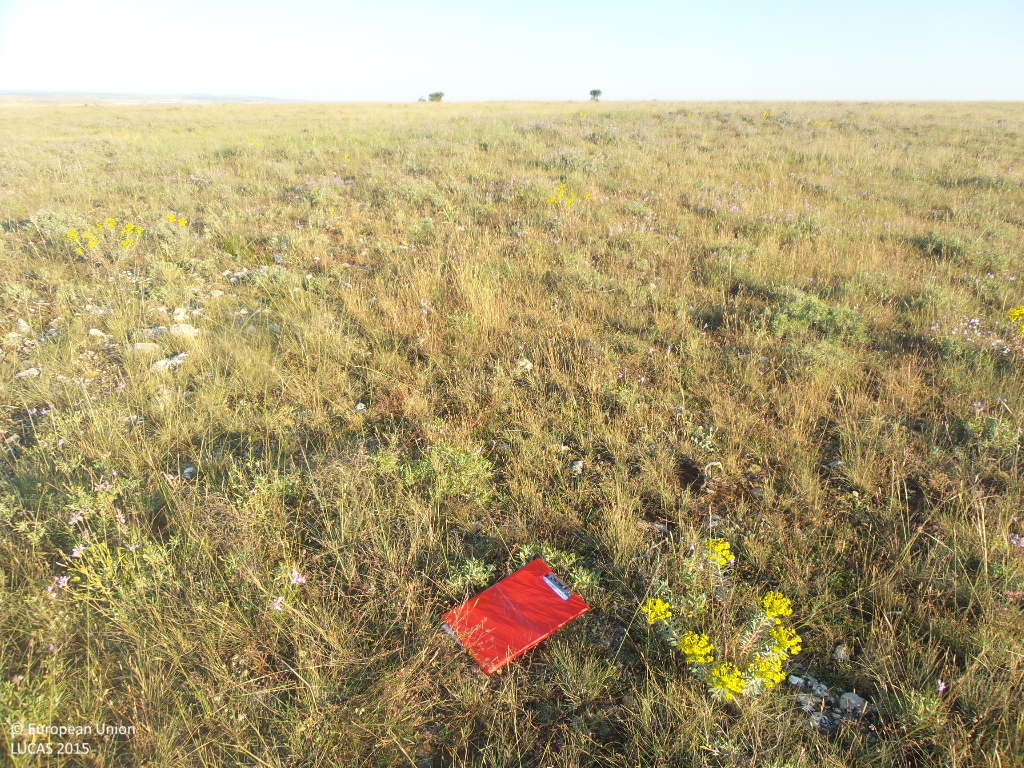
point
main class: Shrubland
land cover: Shrubland without tree cover
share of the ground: 25 - 50 %
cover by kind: shrubs 40 %, herbaceous plants 40 %, unconsolidated bare surface 20 %
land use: Semi-natural and natural areas not in use
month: June
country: ES
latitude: 41.3377
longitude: -2.7149
